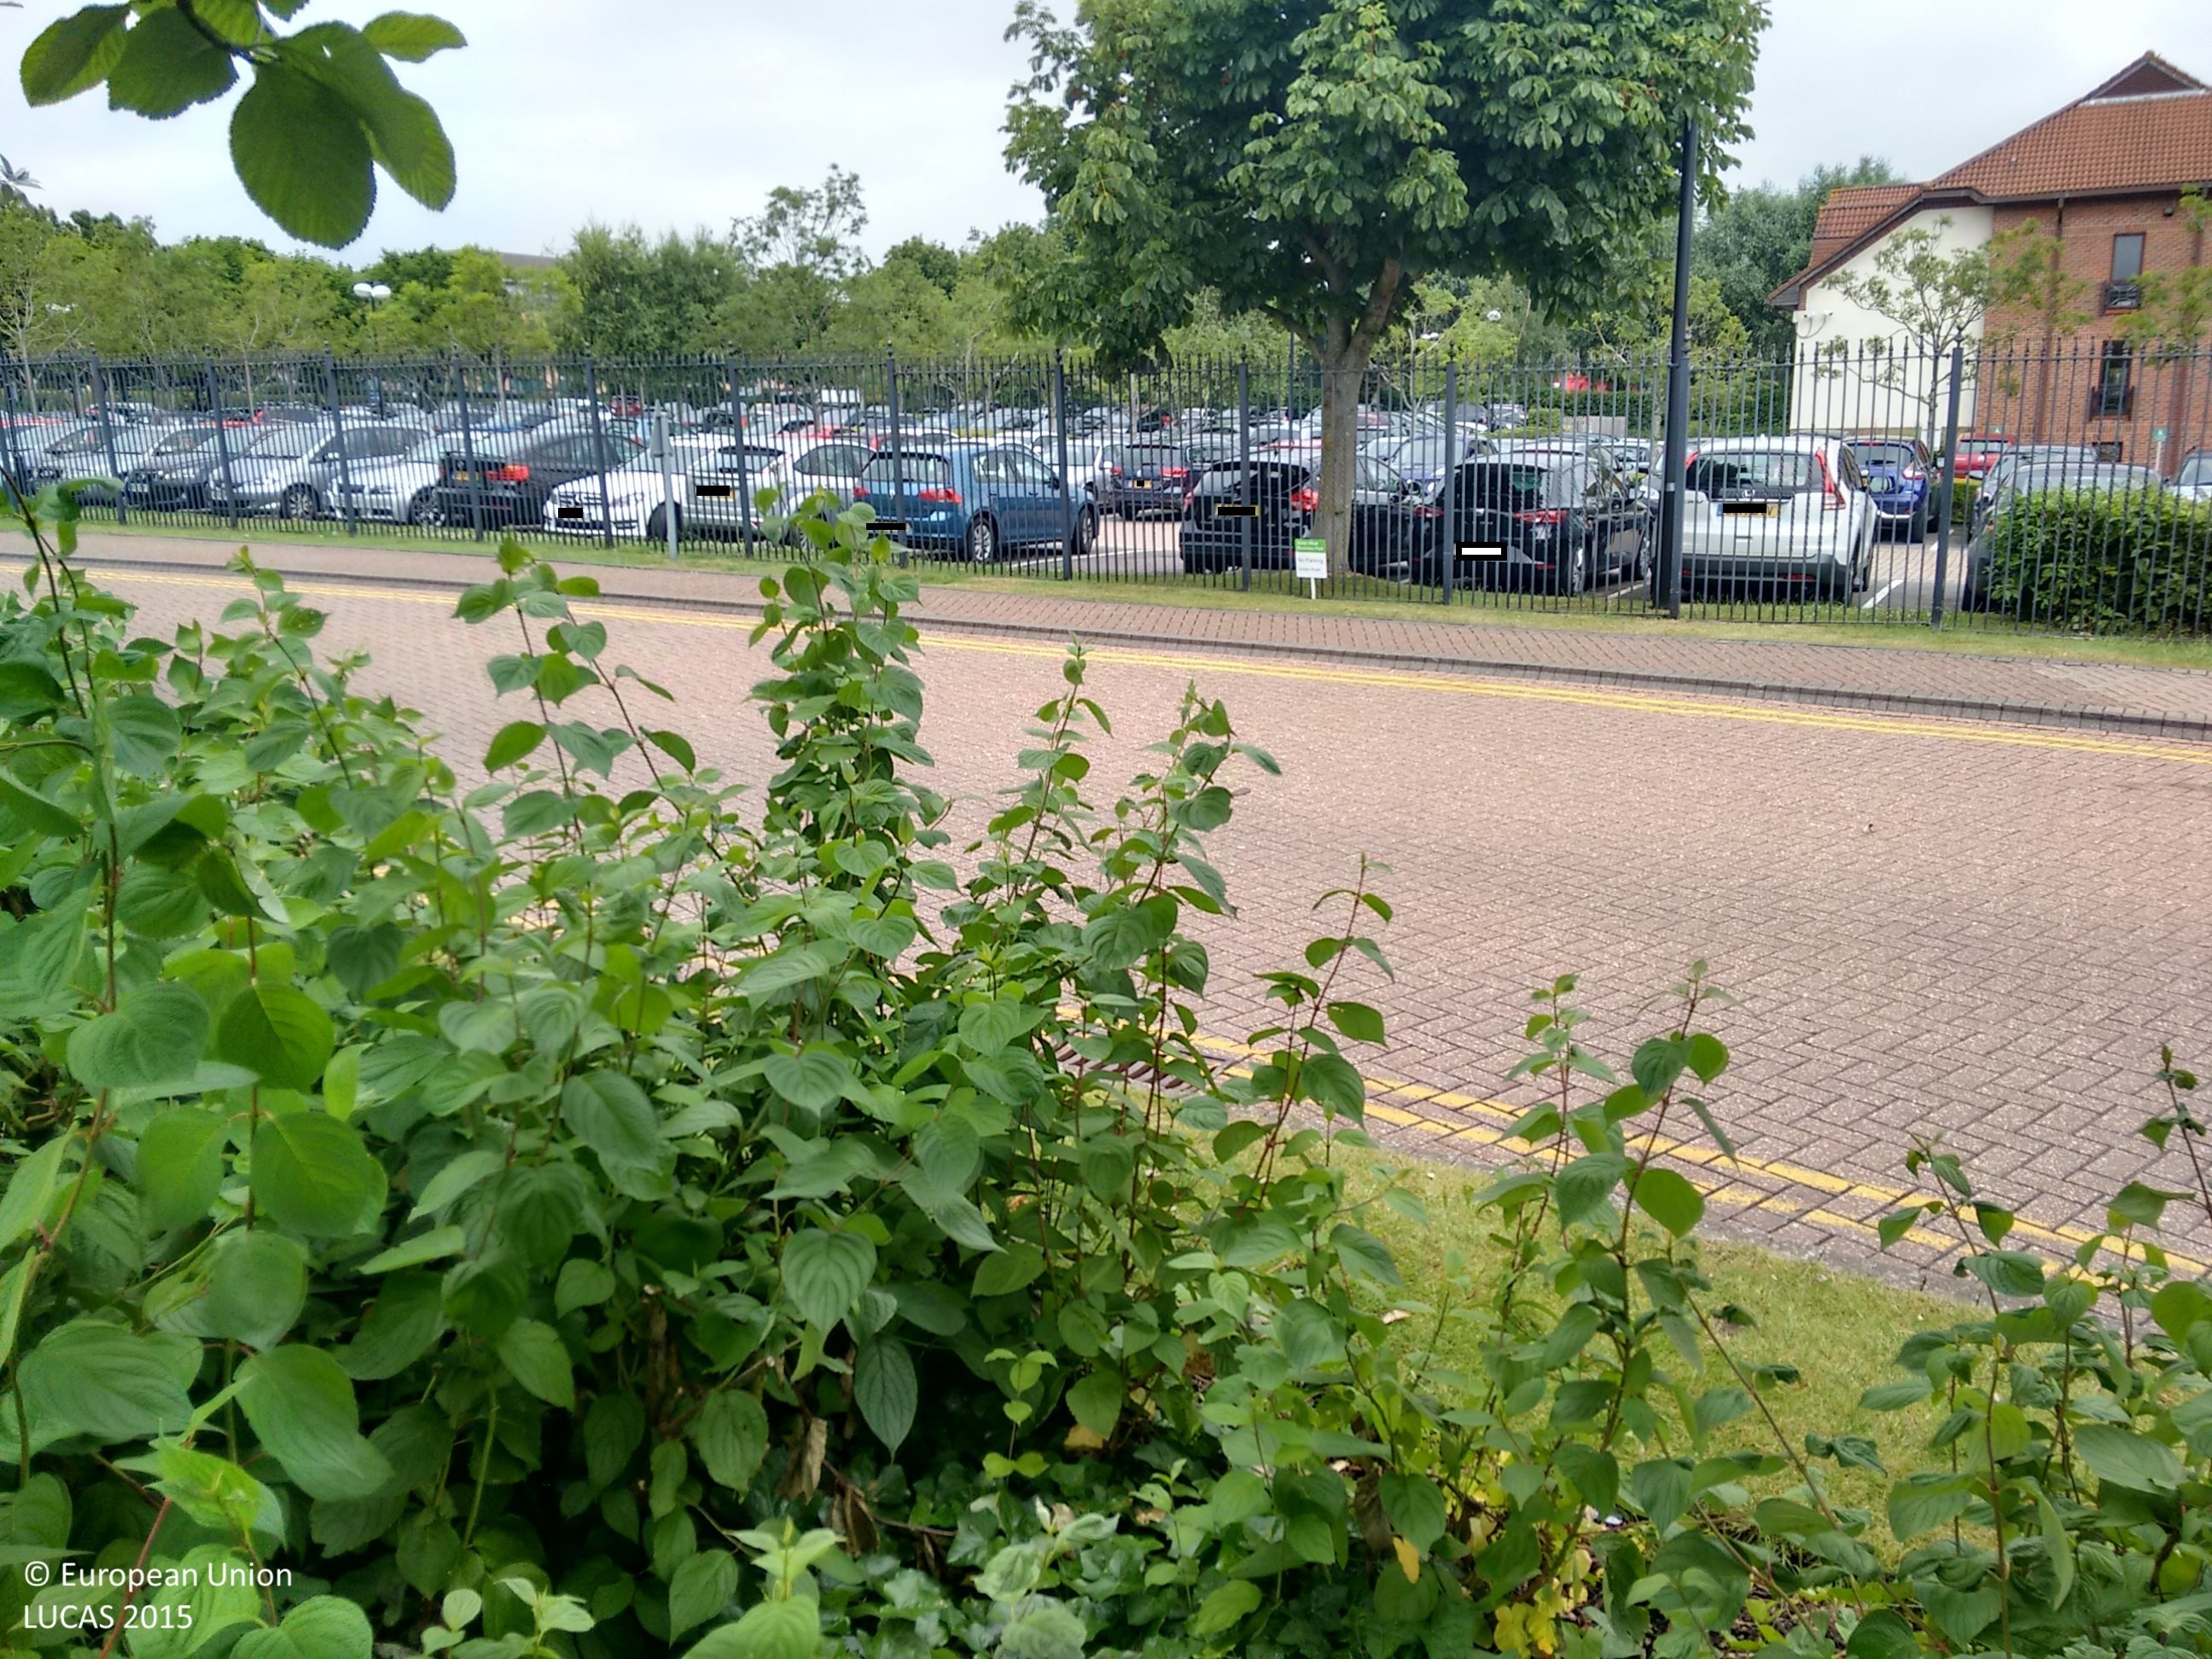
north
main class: Woodland
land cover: Broadleaved woodland
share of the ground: > 75 %
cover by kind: broadleaved forest trees 100 %
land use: Semi-natural and natural areas not in use
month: July
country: GB
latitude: 51.5423
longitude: -2.5688
